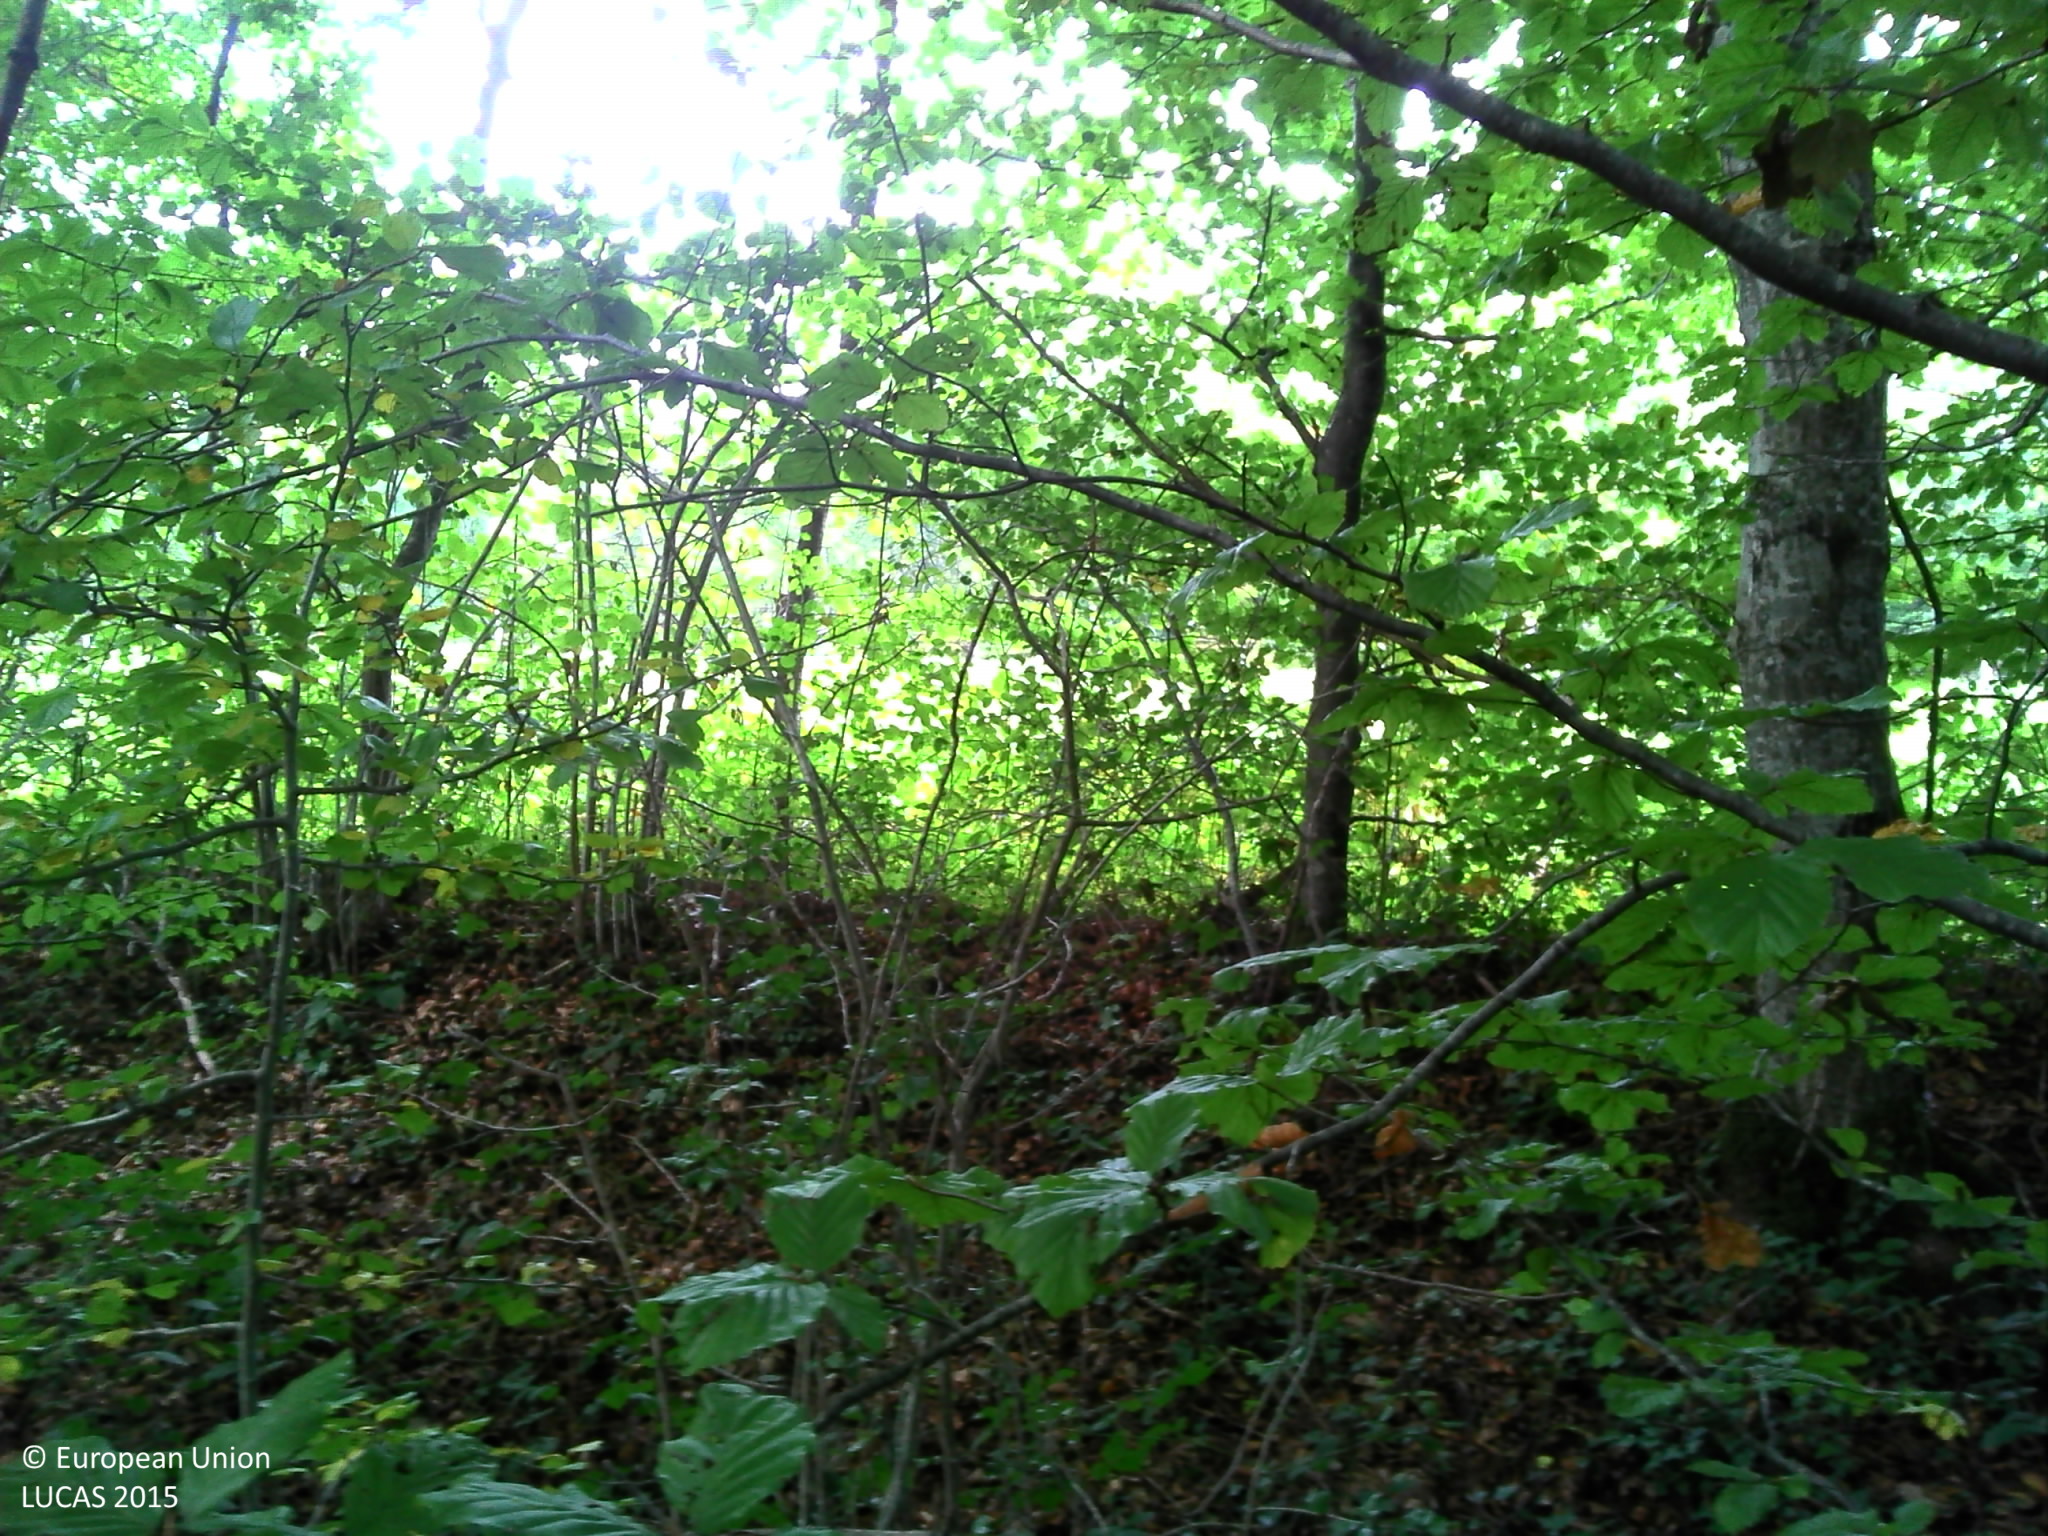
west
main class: Woodland
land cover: Broadleaved woodland
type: beech forest
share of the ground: > 75 %
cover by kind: broadleaved forest trees 90 %, herbaceous plants 5 %, unconsolidated bare surface 5 %
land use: Forestry
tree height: > 5 m
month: October
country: FR
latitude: 47.0749
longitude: 6.1434
